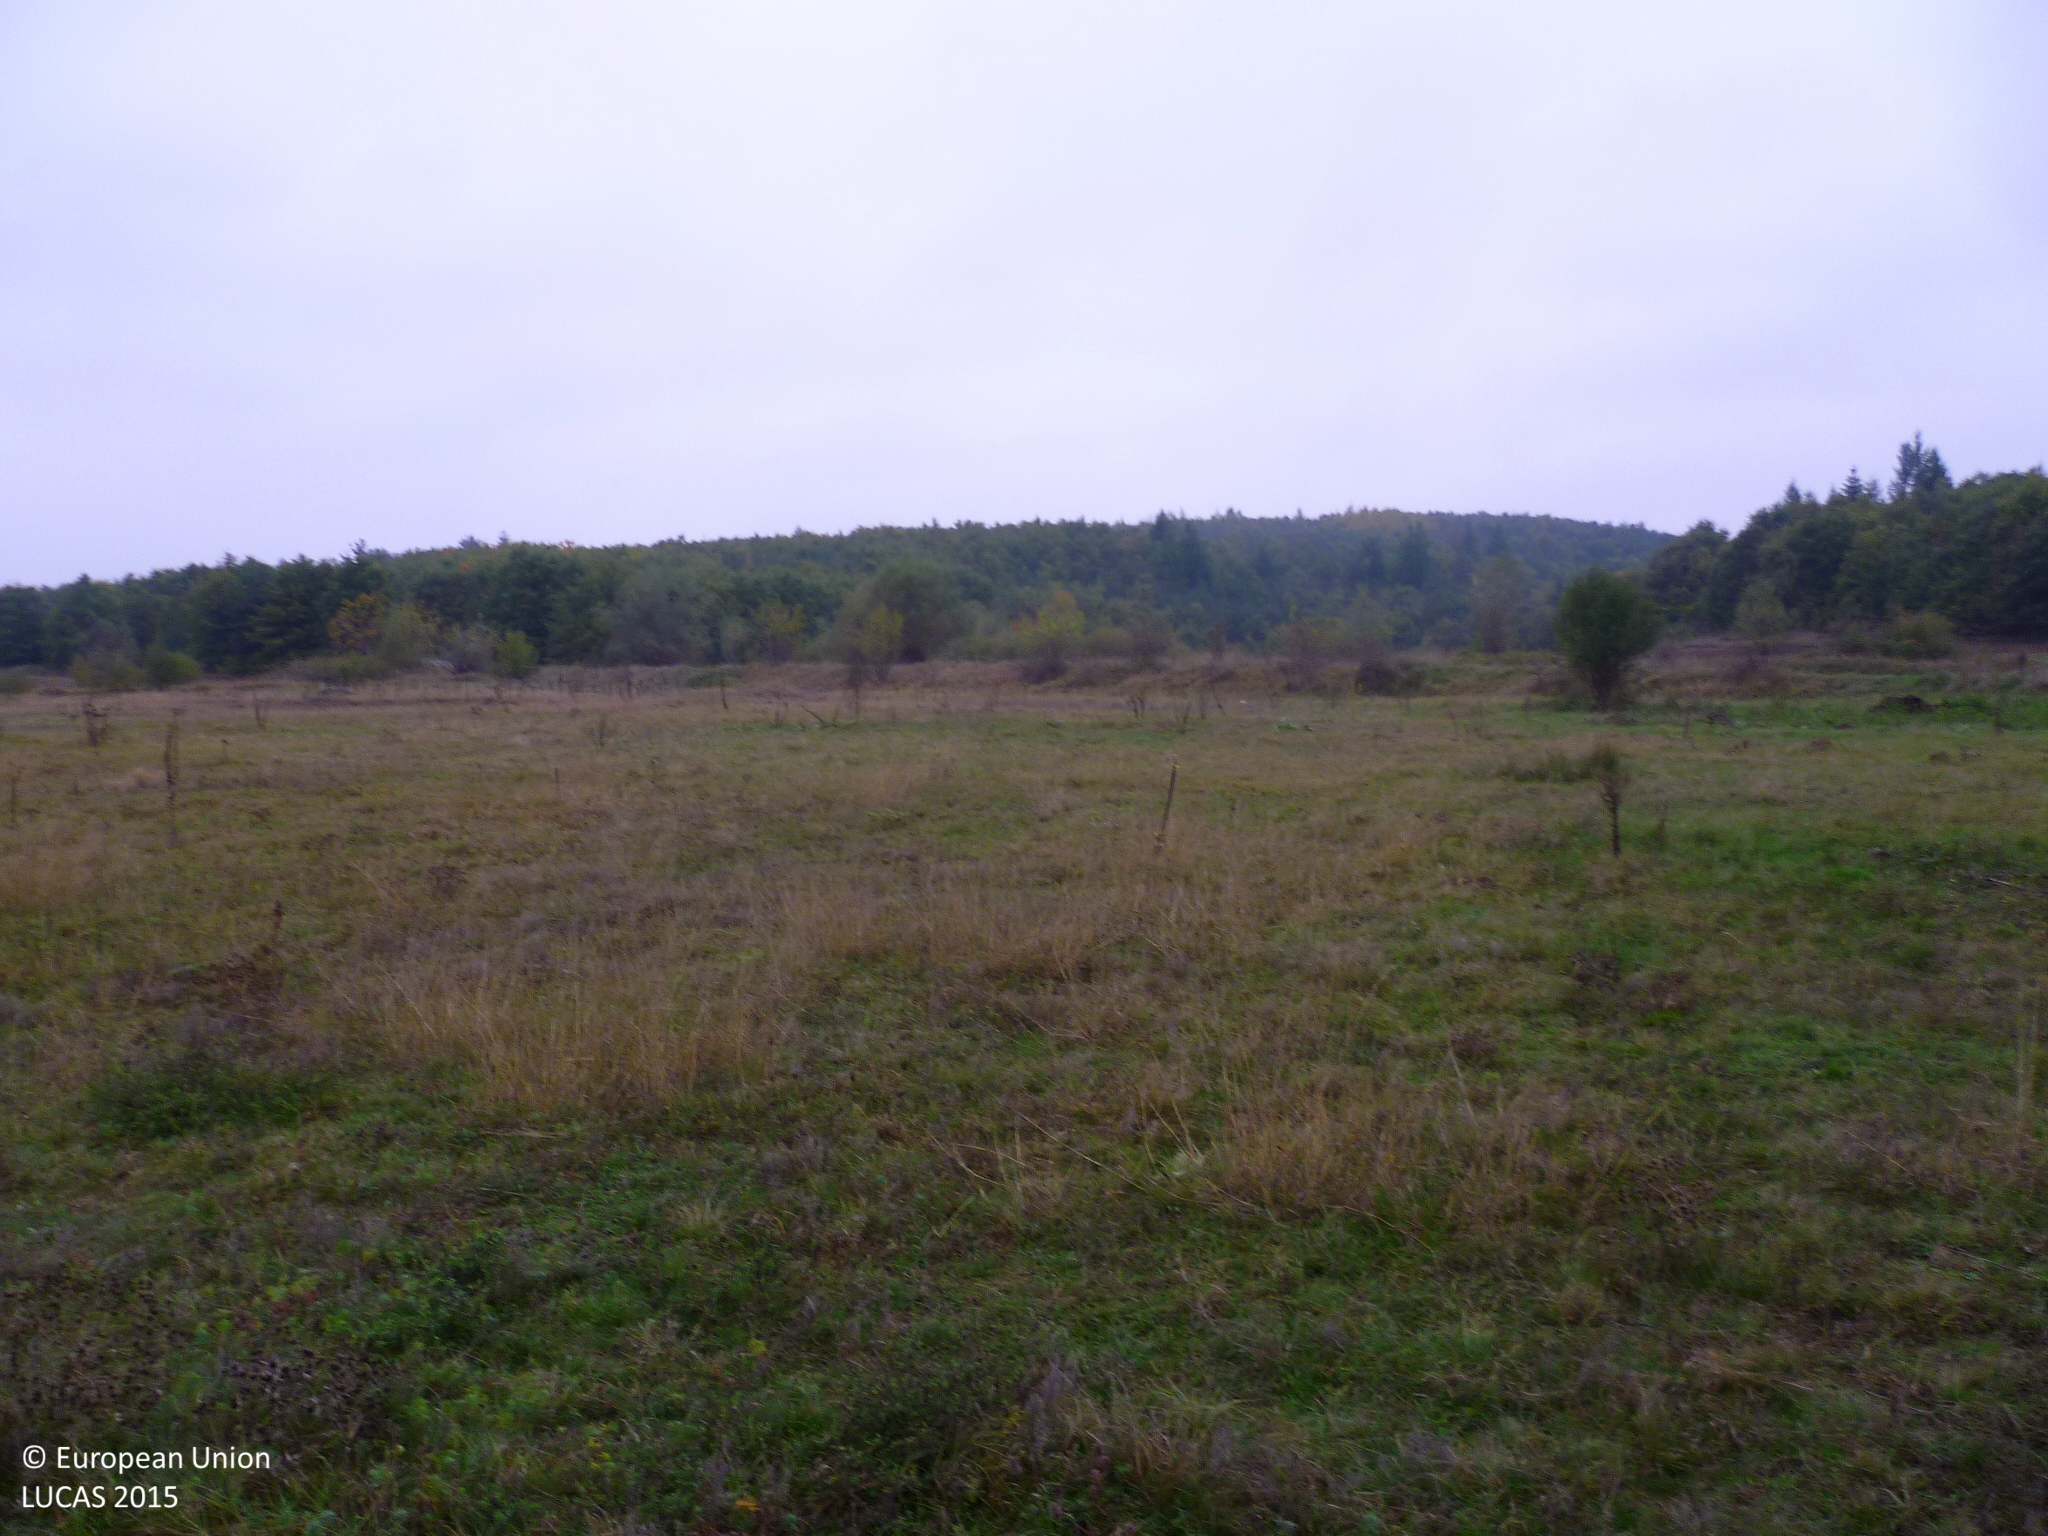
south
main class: Grassland
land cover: Grassland without tree/shrub cover
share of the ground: > 75 %
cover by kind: herbaceous plants 100 %
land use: Agriculture (excluding fallow land and kitchen gardens)
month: October
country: BG
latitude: 42.3459
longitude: 23.7909
